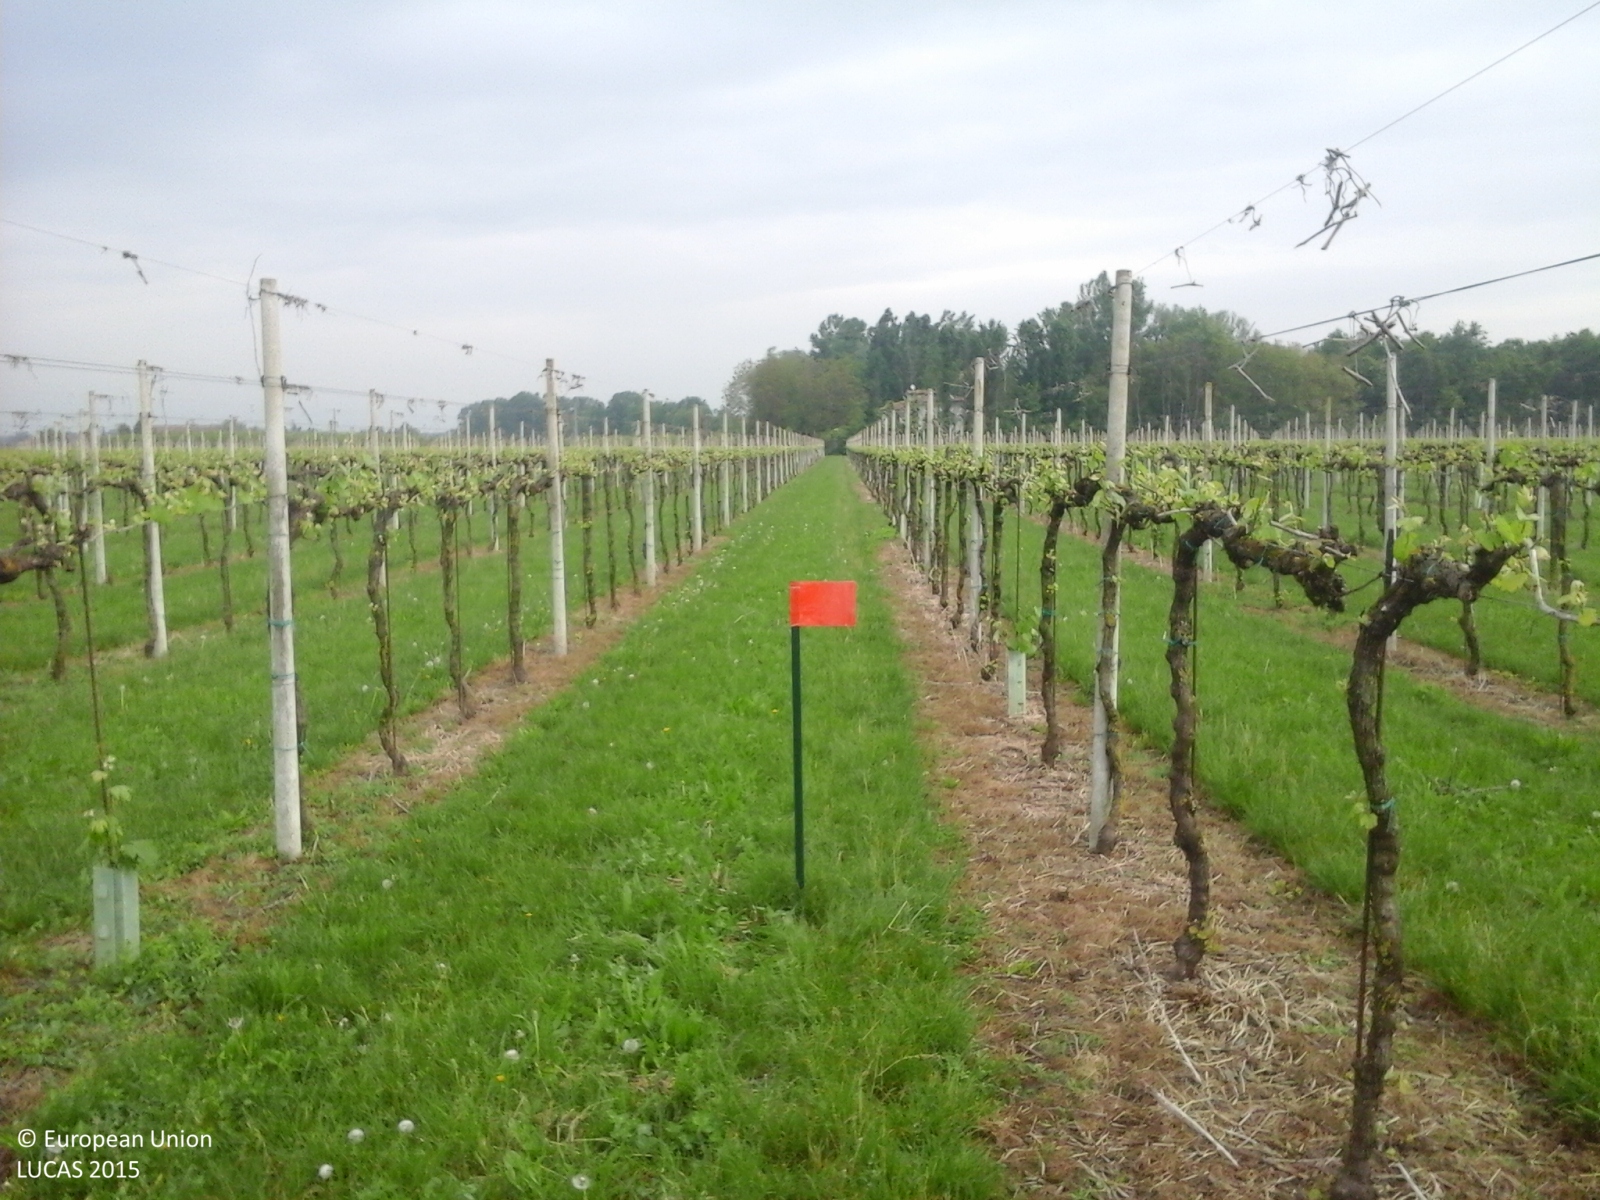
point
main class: Cropland
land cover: Vineyards
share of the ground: 10 - 25 %
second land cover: Grassland without tree/shrub cover
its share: > 75 %
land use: Agriculture (excluding fallow land and kitchen gardens)
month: April
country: IT
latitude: 44.8879
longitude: 10.8719
